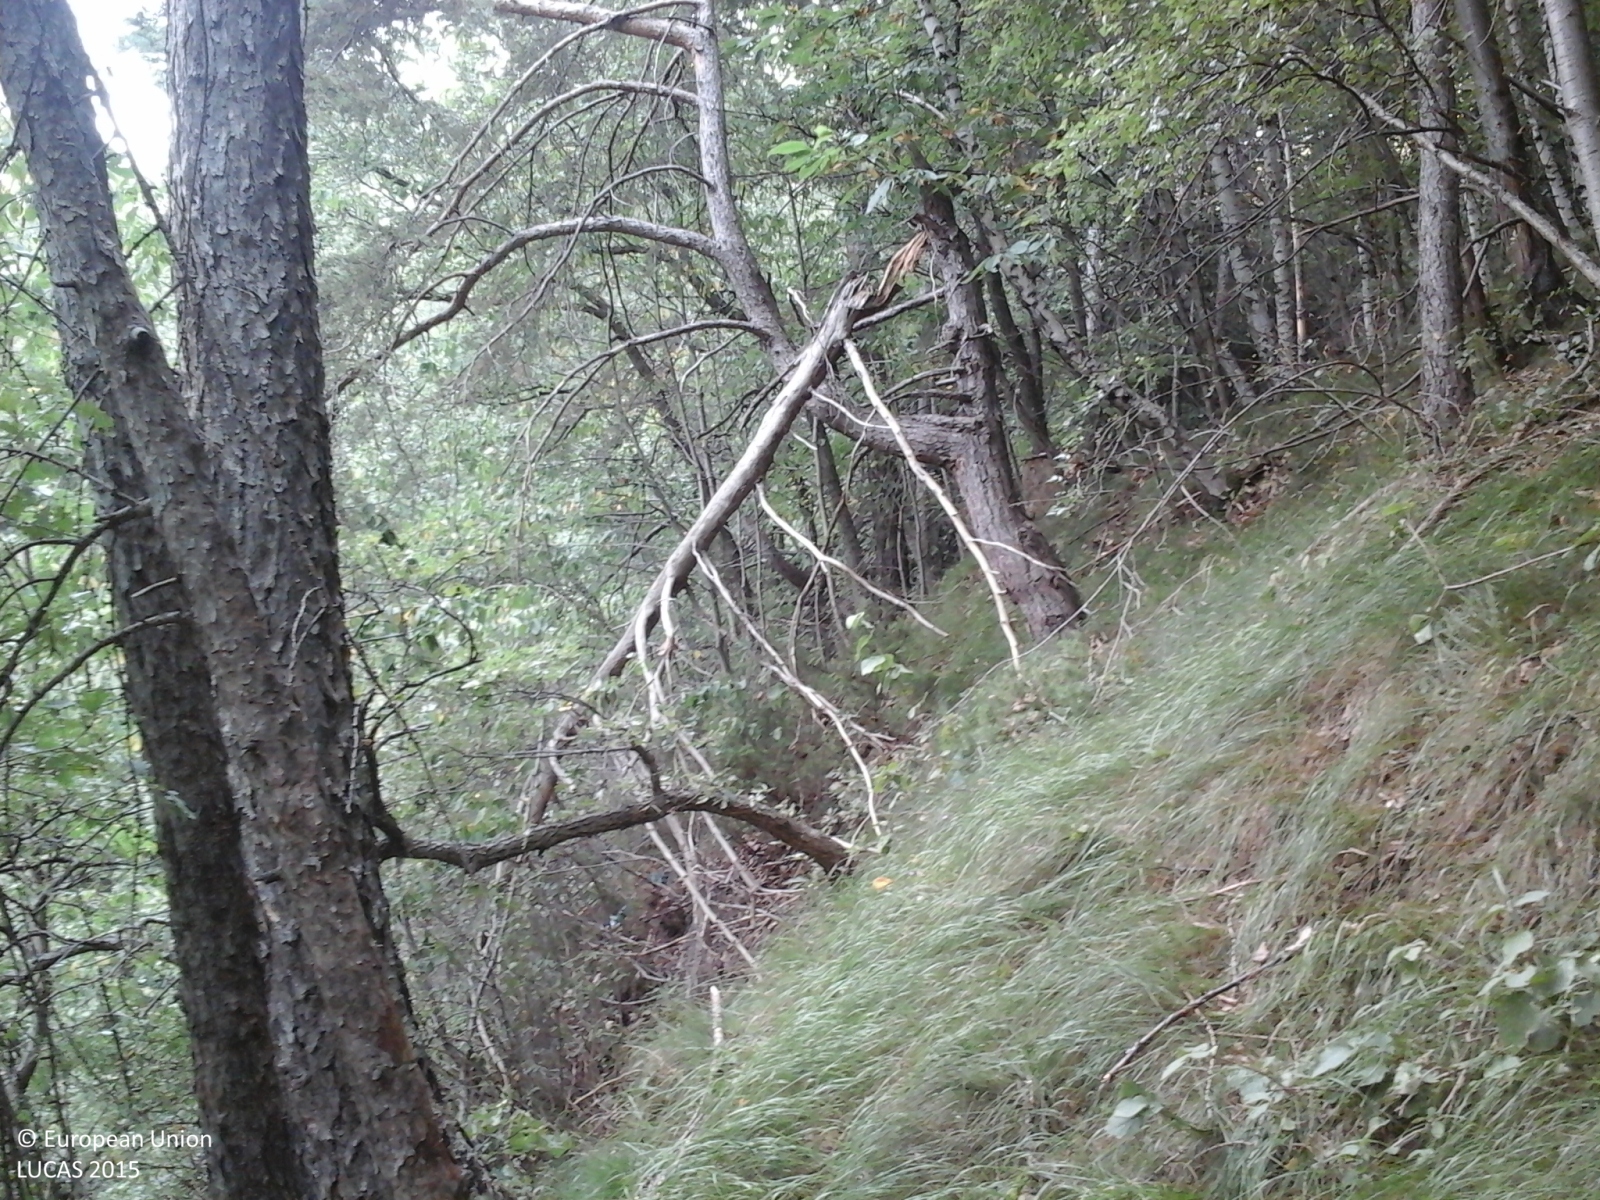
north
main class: Woodland
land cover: Broadleaved woodland
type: mesophytic deciduous forest
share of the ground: > 75 %
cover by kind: broadleaved forest trees 80 %, coniferous forest trees 20 %
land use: Semi-natural and natural areas not in use
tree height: > 5 m
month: August
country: IT
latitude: 45.6964
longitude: 7.7302
